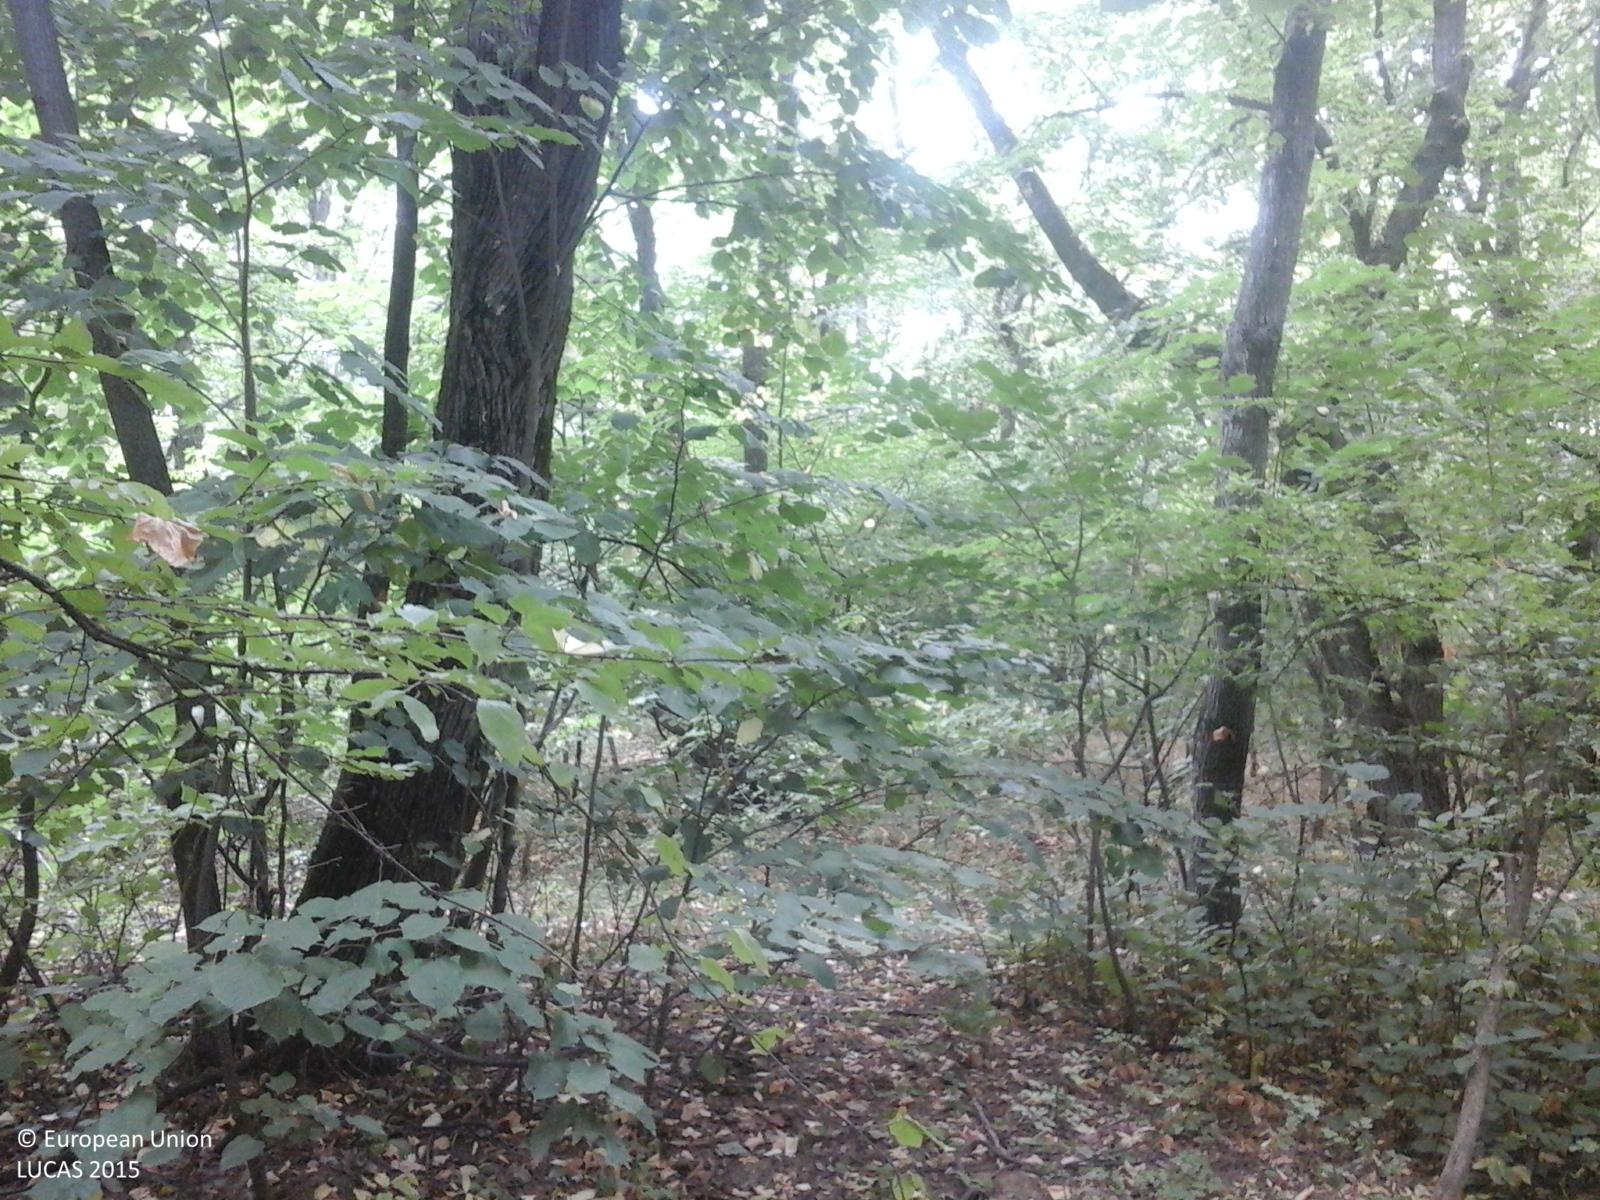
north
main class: Woodland
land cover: Broadleaved woodland
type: mesophytic deciduous forest
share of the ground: > 75 %
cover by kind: broadleaved forest trees 100 %
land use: Forestry
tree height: > 5 m
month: July
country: RO
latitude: 45.2559
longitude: 28.3881
